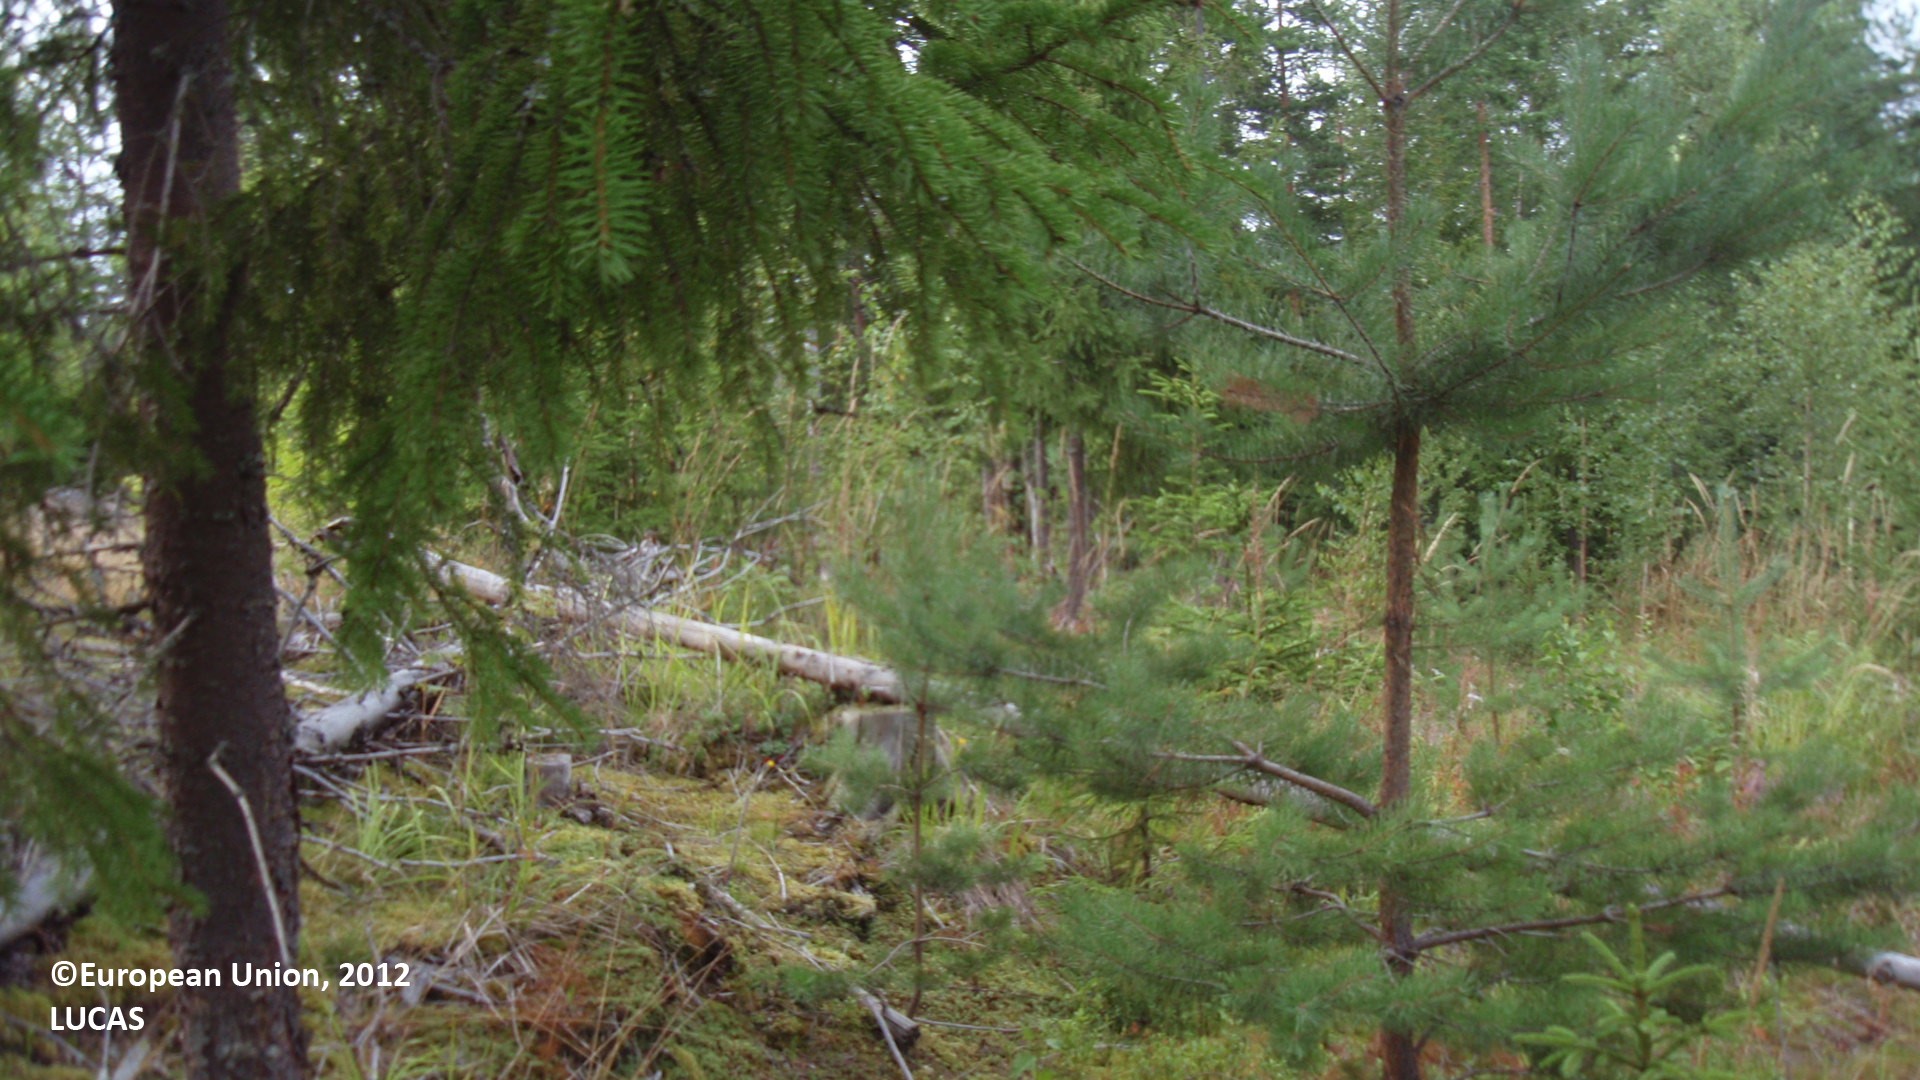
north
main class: Woodland
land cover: Spruce dominated mixed woodland
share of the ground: 50 - 75 %
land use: Forestry
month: August
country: FI
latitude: 60.9978
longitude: 27.6601
